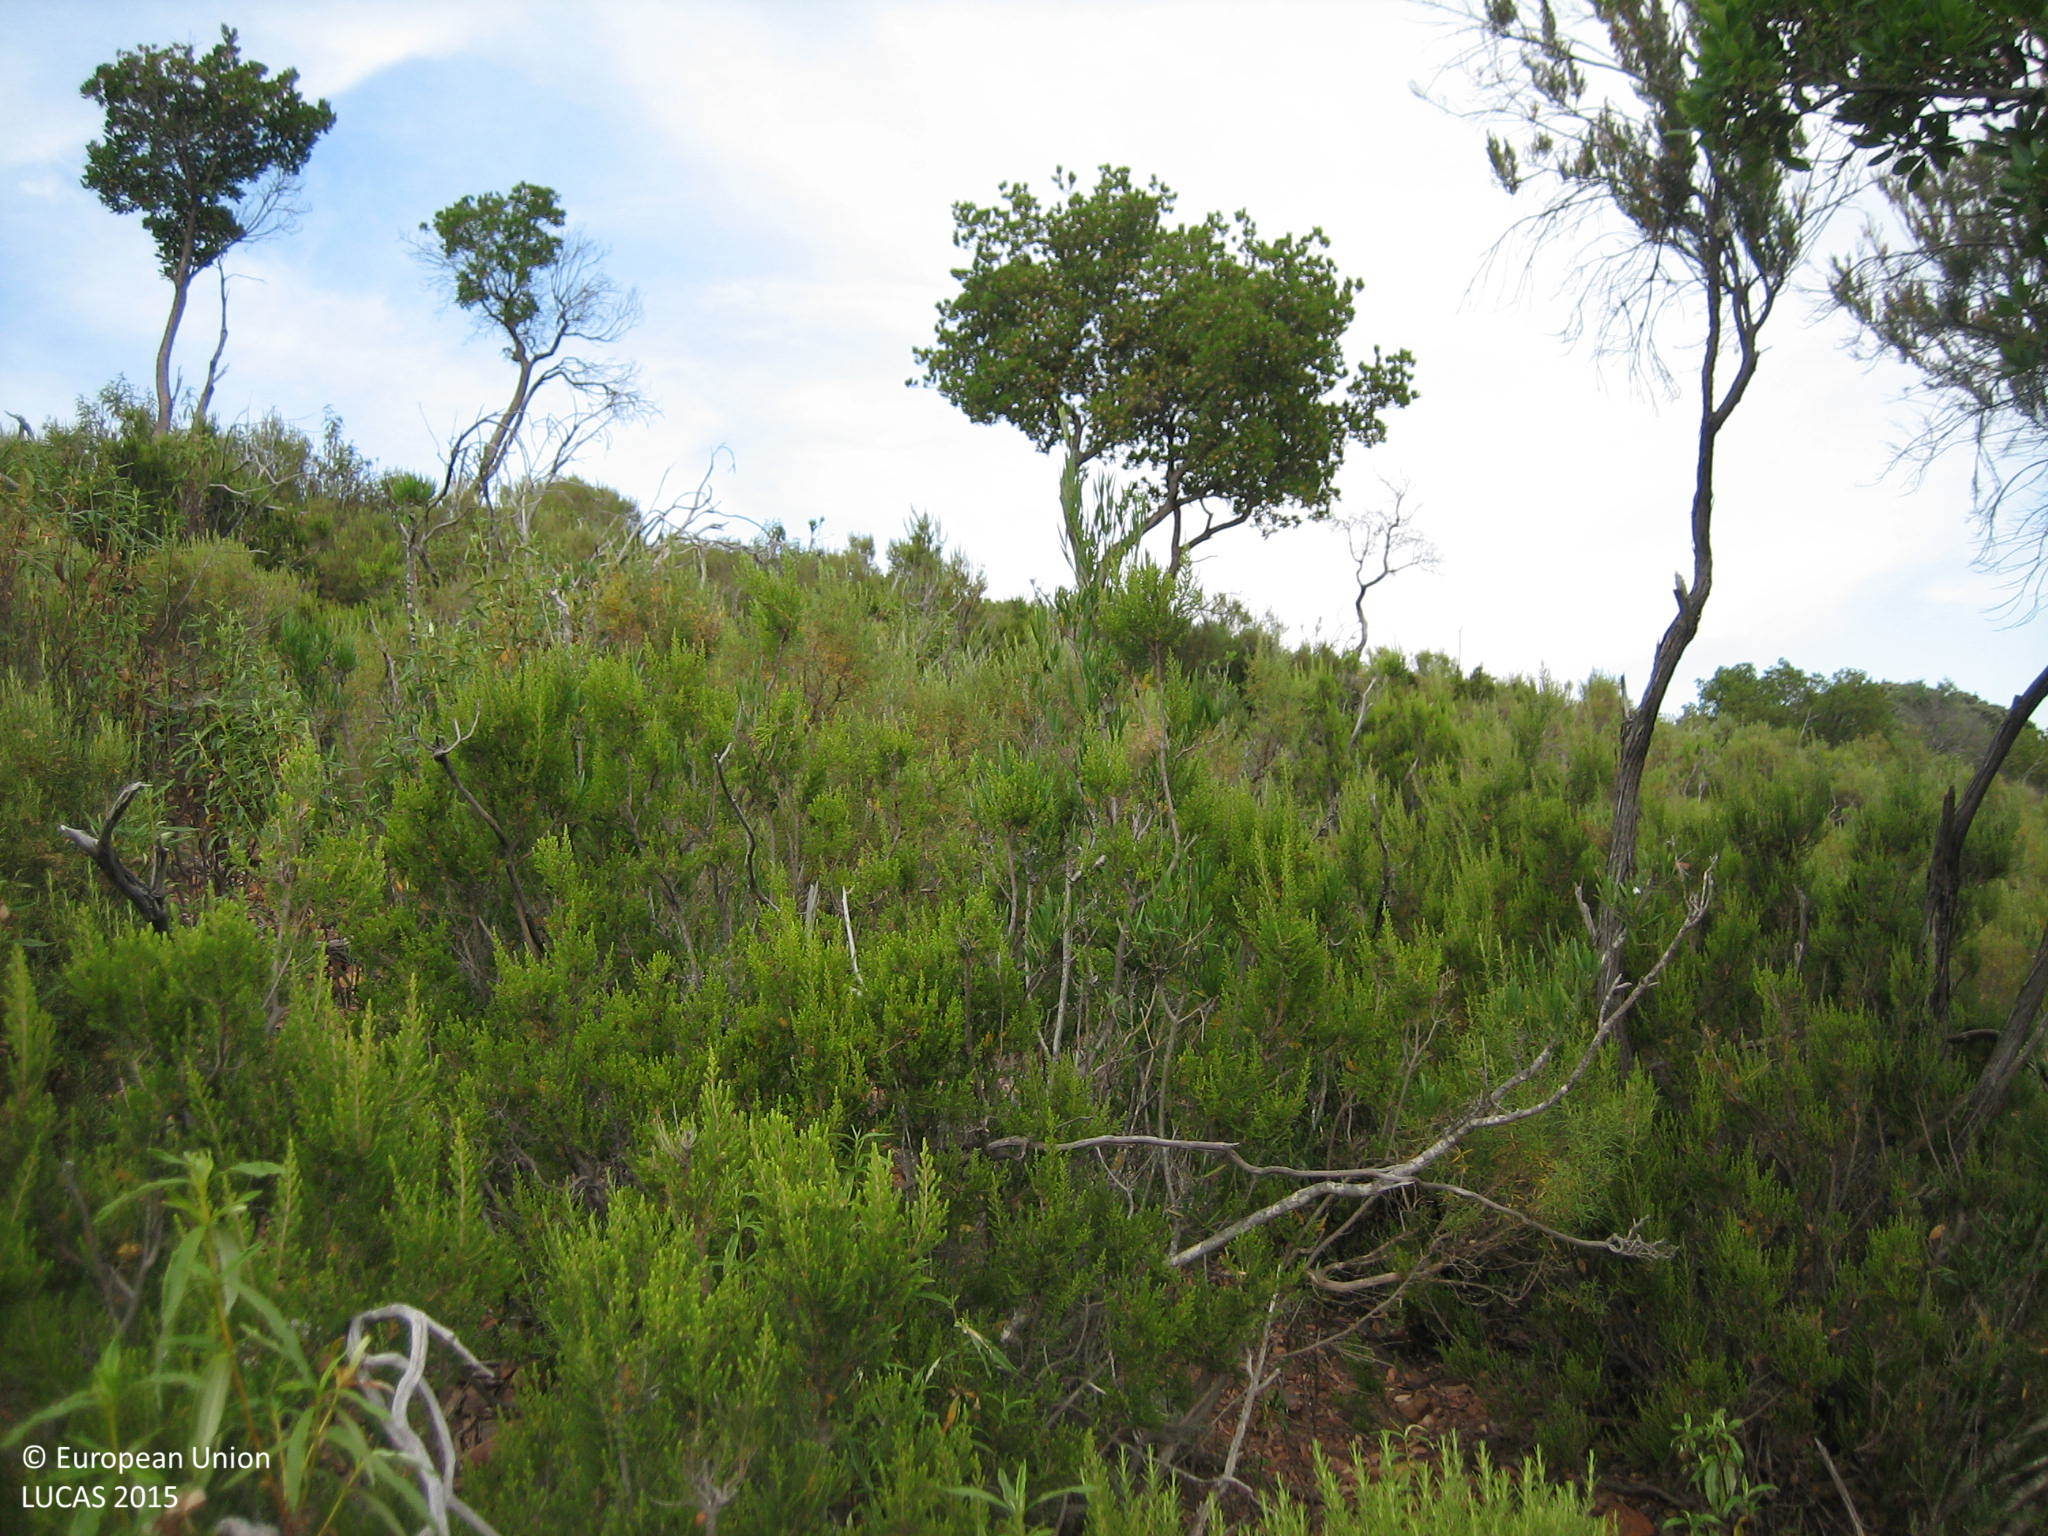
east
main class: Shrubland
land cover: Shrubland with sparse tree cover
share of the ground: > 75 %
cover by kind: shrubs 90 %, broadleaved forest trees 5 %, herbaceous plants 5 %
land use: Semi-natural and natural areas not in use
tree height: > 5 m
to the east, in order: Shrubland with sparse tree cover; Other bare soil; Tracks; Other bare soil
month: June
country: ES
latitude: 39.1294
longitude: -4.7364
